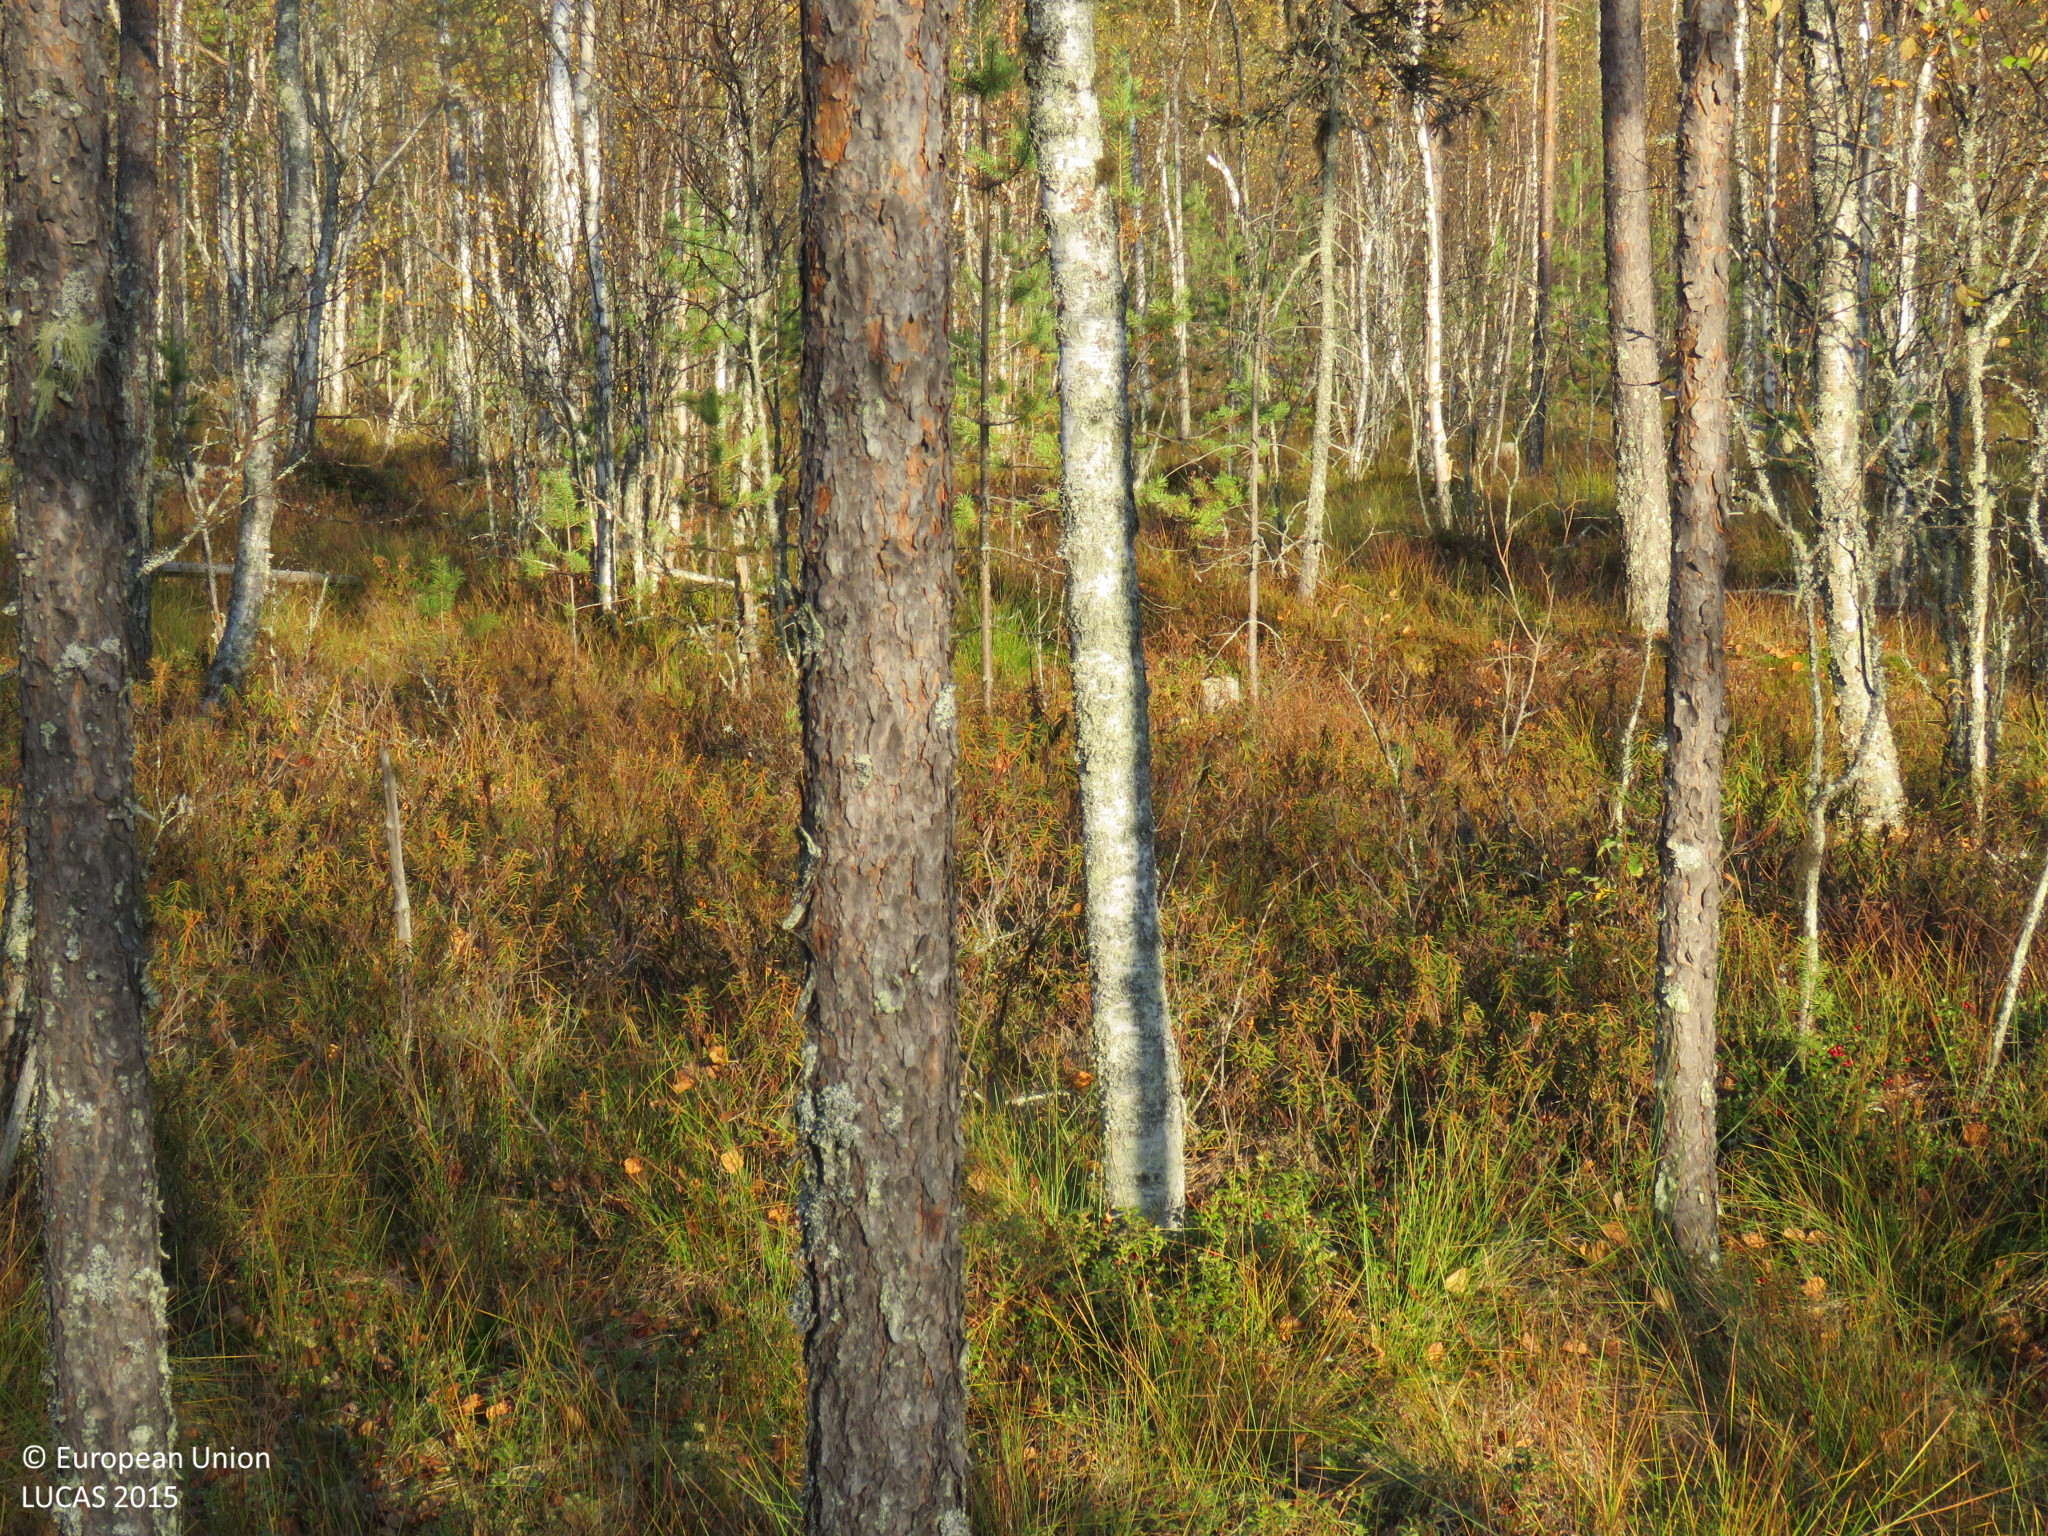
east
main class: Woodland
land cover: Pine dominated mixed woodland
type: mire and swamp forests
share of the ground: > 75 %
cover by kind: broadleaved forest trees 45 %, coniferous forest trees 35 %, shrubs 10 %, herbaceous plants 10 %
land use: Forestry
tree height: > 5 m
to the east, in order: Pine dominated mixed woodland; Ditches and canals; Broadleaved woodland; Ditches and canals; Broadleaved woodland; Ditches and canals; Broadleaved woodland; Ditches and canals; Pine dominated mixed woodland; Ditches and canals; Broadleaved woodland; Ditches and canals; Other mixed woodland
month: September
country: FI
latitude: 64.7648
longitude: 26.5302
